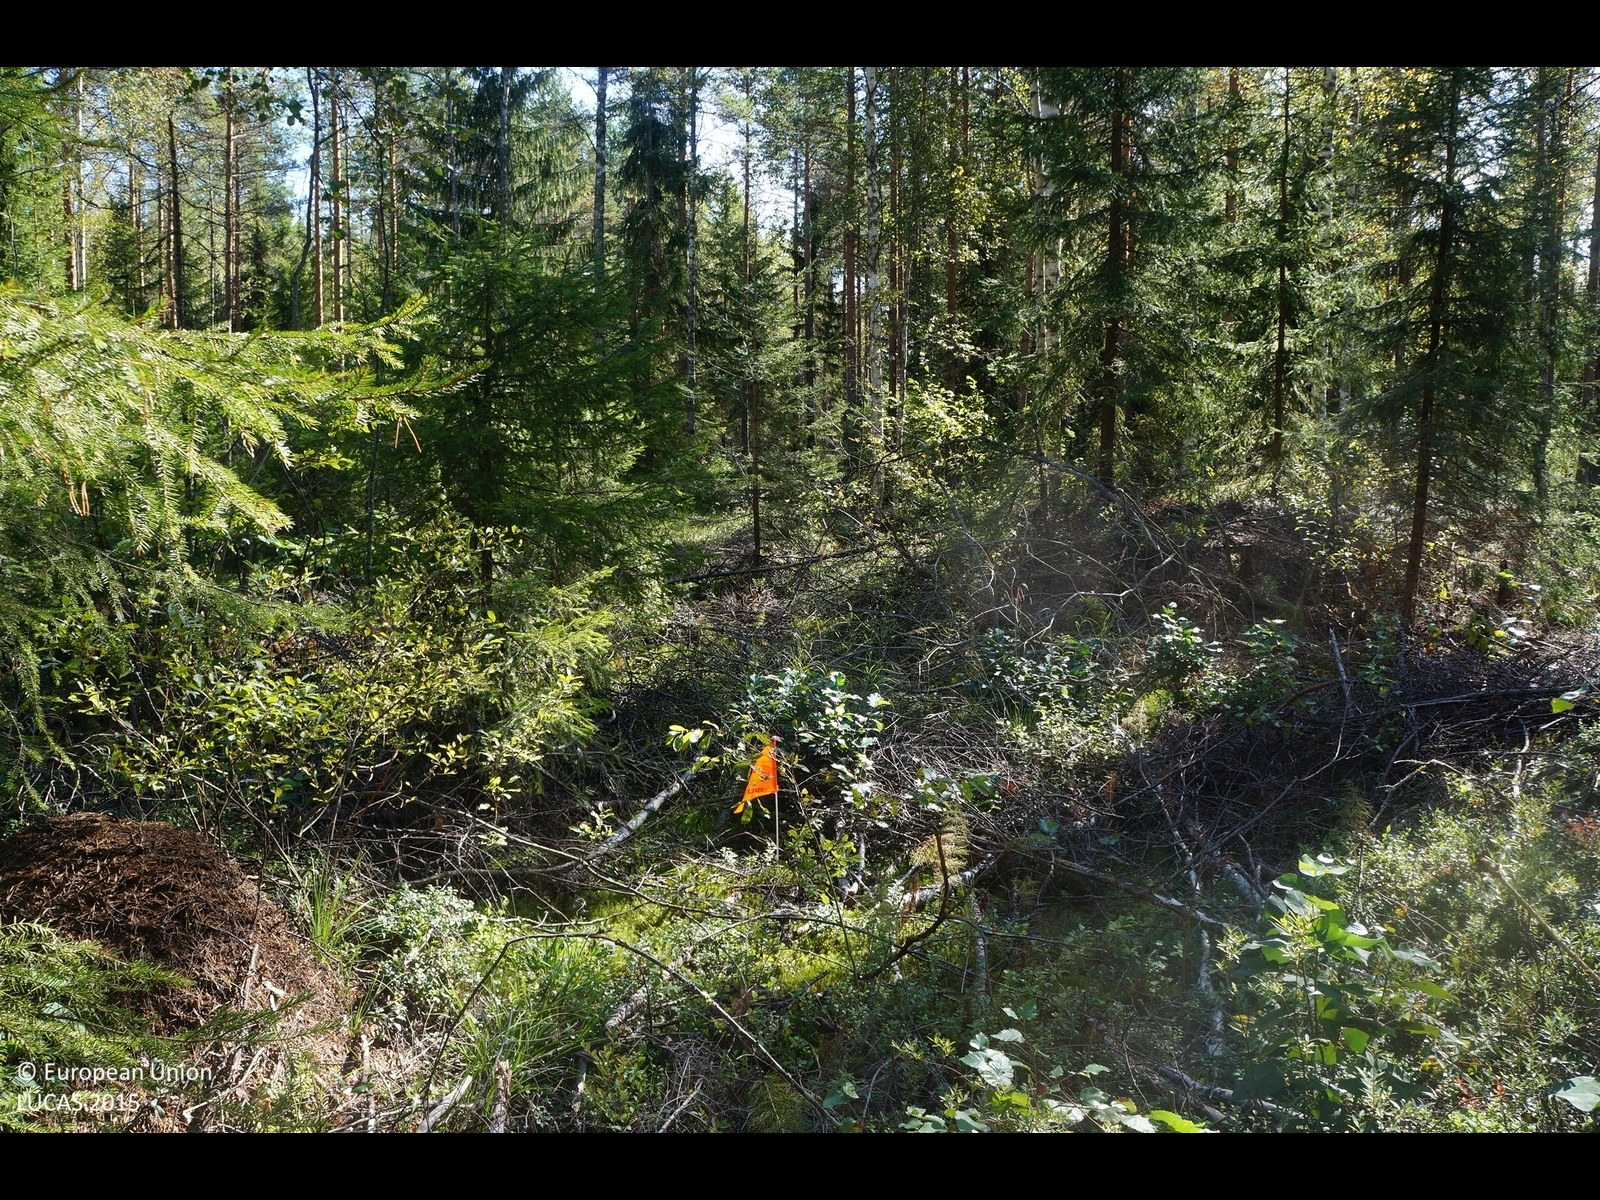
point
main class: Woodland
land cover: Other mixed woodland
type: boreal forest
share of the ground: 50 - 75 %
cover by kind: coniferous forest trees 40 %, shrubs 30 %, broadleaved forest trees 20 %, lichens and mosses 10 %
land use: Forestry
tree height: > 5 m
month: September
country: FI
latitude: 63.8615
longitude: 24.0448
